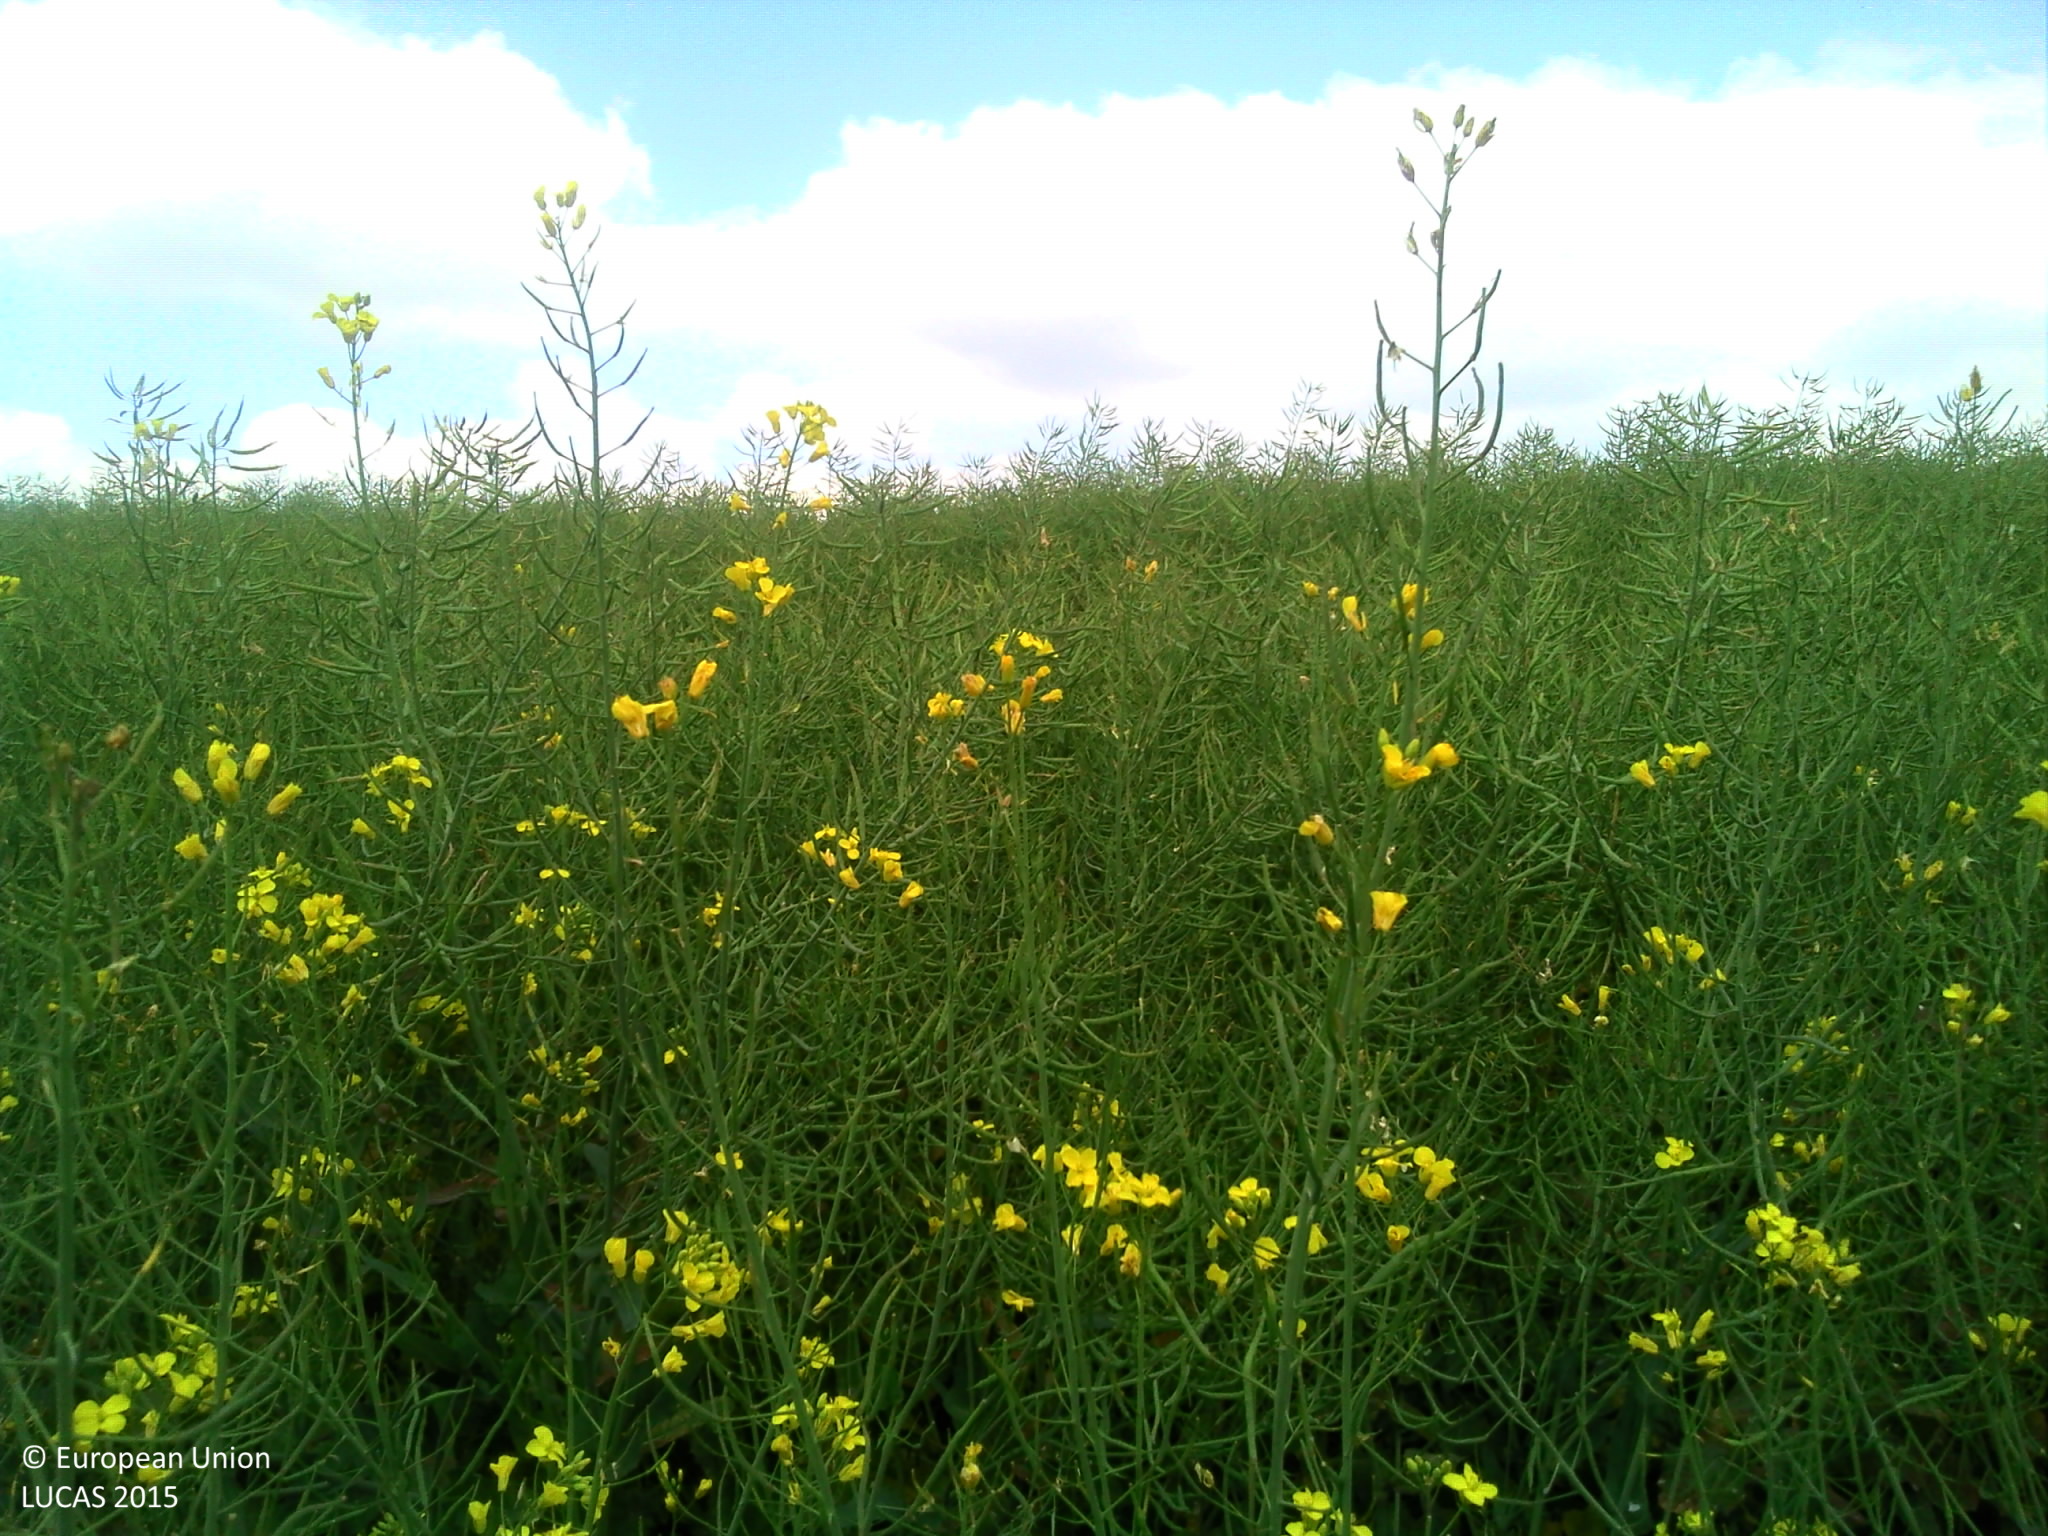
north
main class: Cropland
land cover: Rape and turnip rape
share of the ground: > 75 %
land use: Agriculture (excluding fallow land and kitchen gardens)
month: May
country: FR
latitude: 48.7677
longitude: -0.1681
